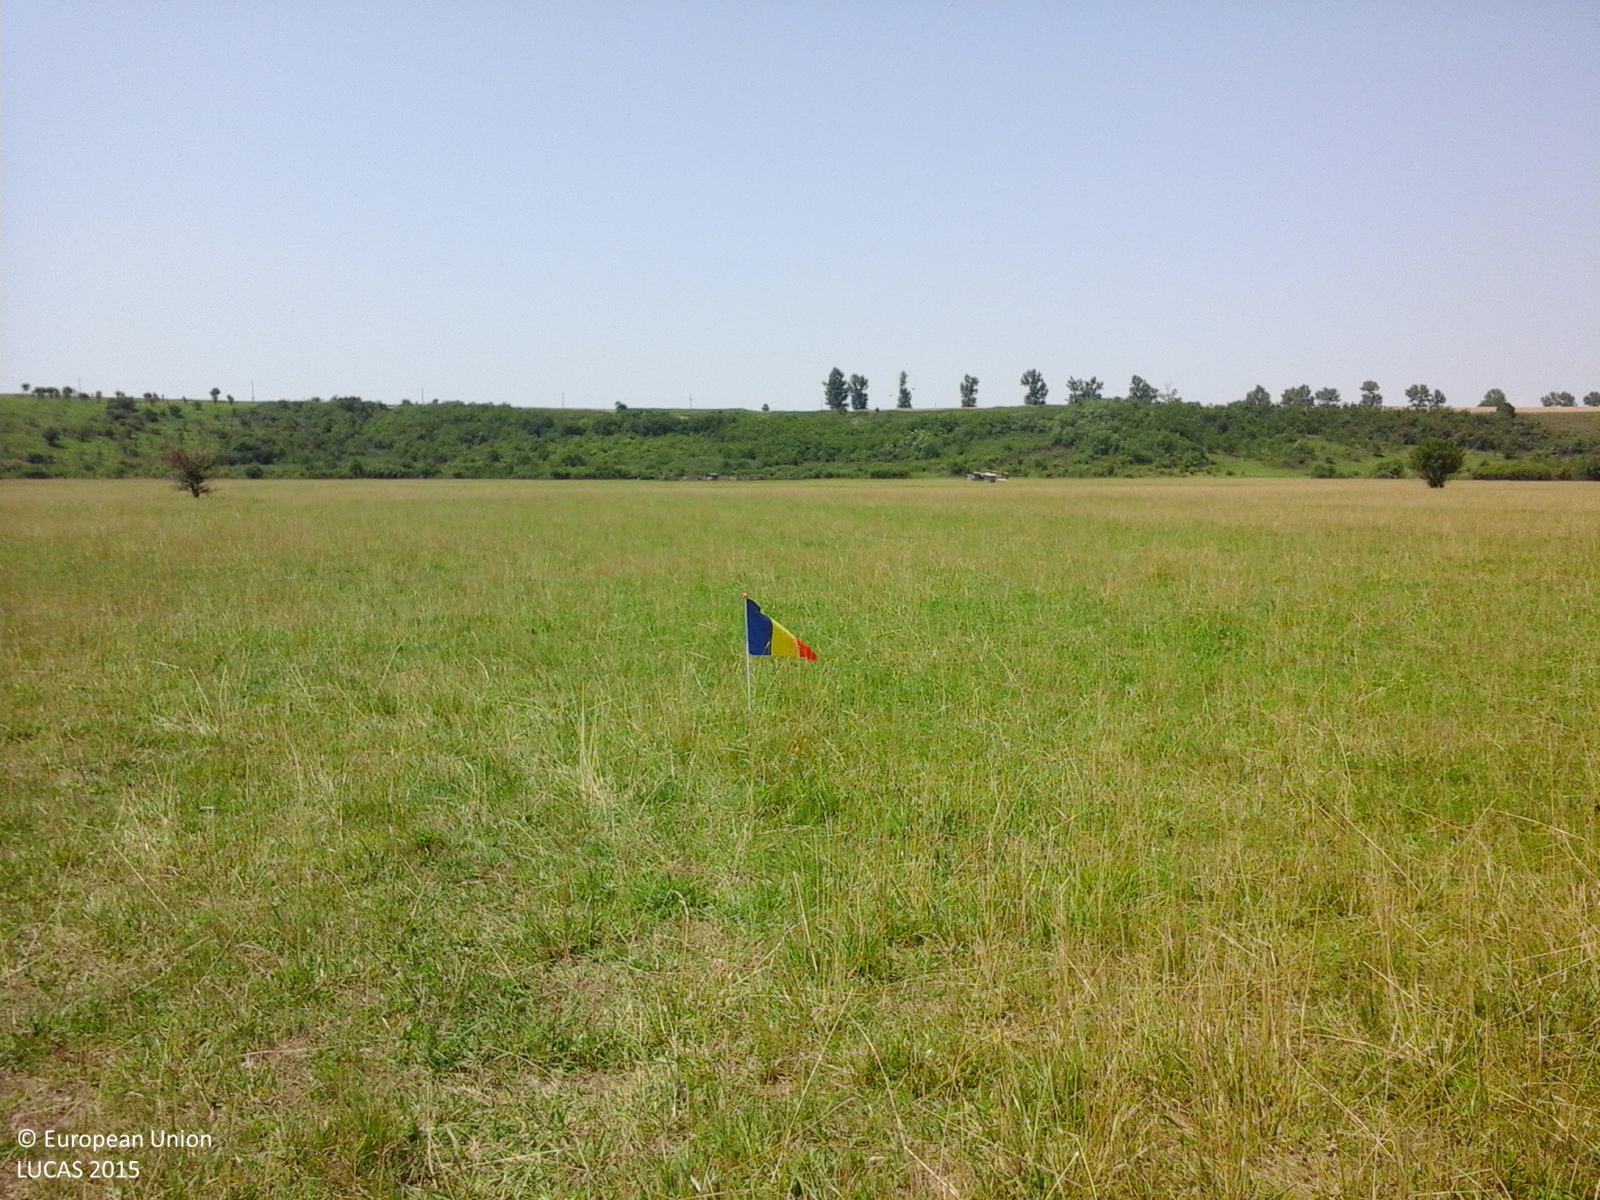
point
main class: Grassland
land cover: Grassland without tree/shrub cover
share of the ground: > 75 %
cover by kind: herbaceous plants 100 %
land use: Agriculture (excluding fallow land and kitchen gardens)
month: July
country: RO
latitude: 44.5609
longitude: 24.9494
